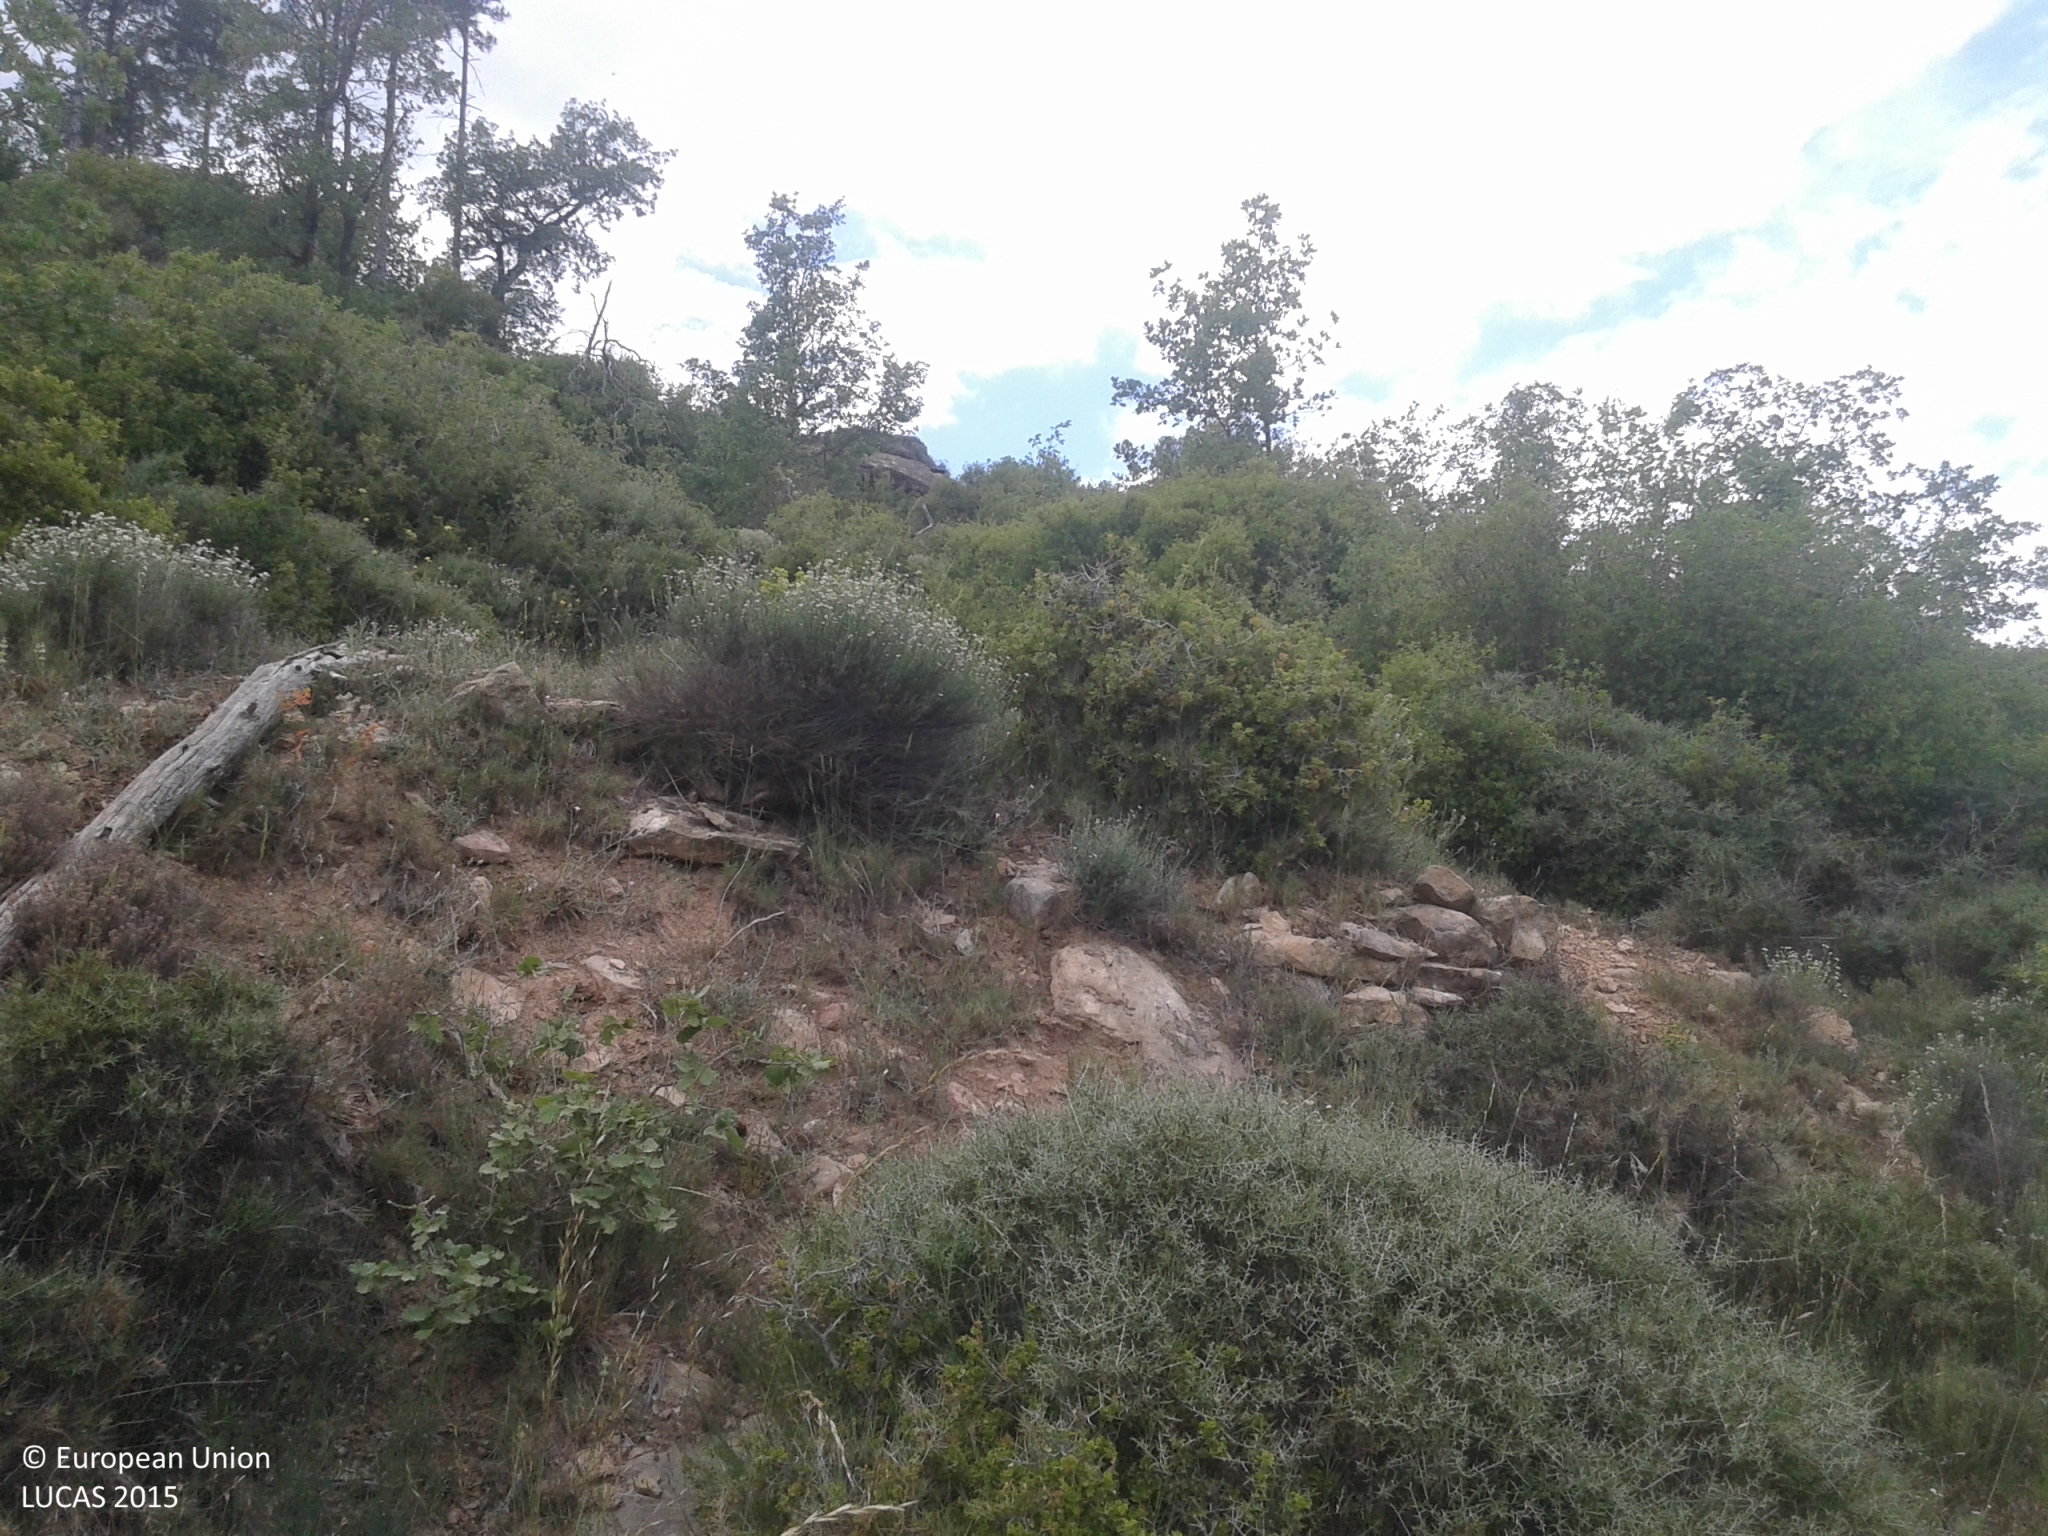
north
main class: Shrubland
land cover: Shrubland with sparse tree cover
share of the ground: > 75 %
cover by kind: shrubs 80 %, herbaceous plants 10 %, broadleaved forest trees 5 %, consolidated bare surface 5 %
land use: Agriculture (excluding fallow land and kitchen gardens)
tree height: < 5 m
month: May
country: ES
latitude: 41.8663
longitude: 1.5682
